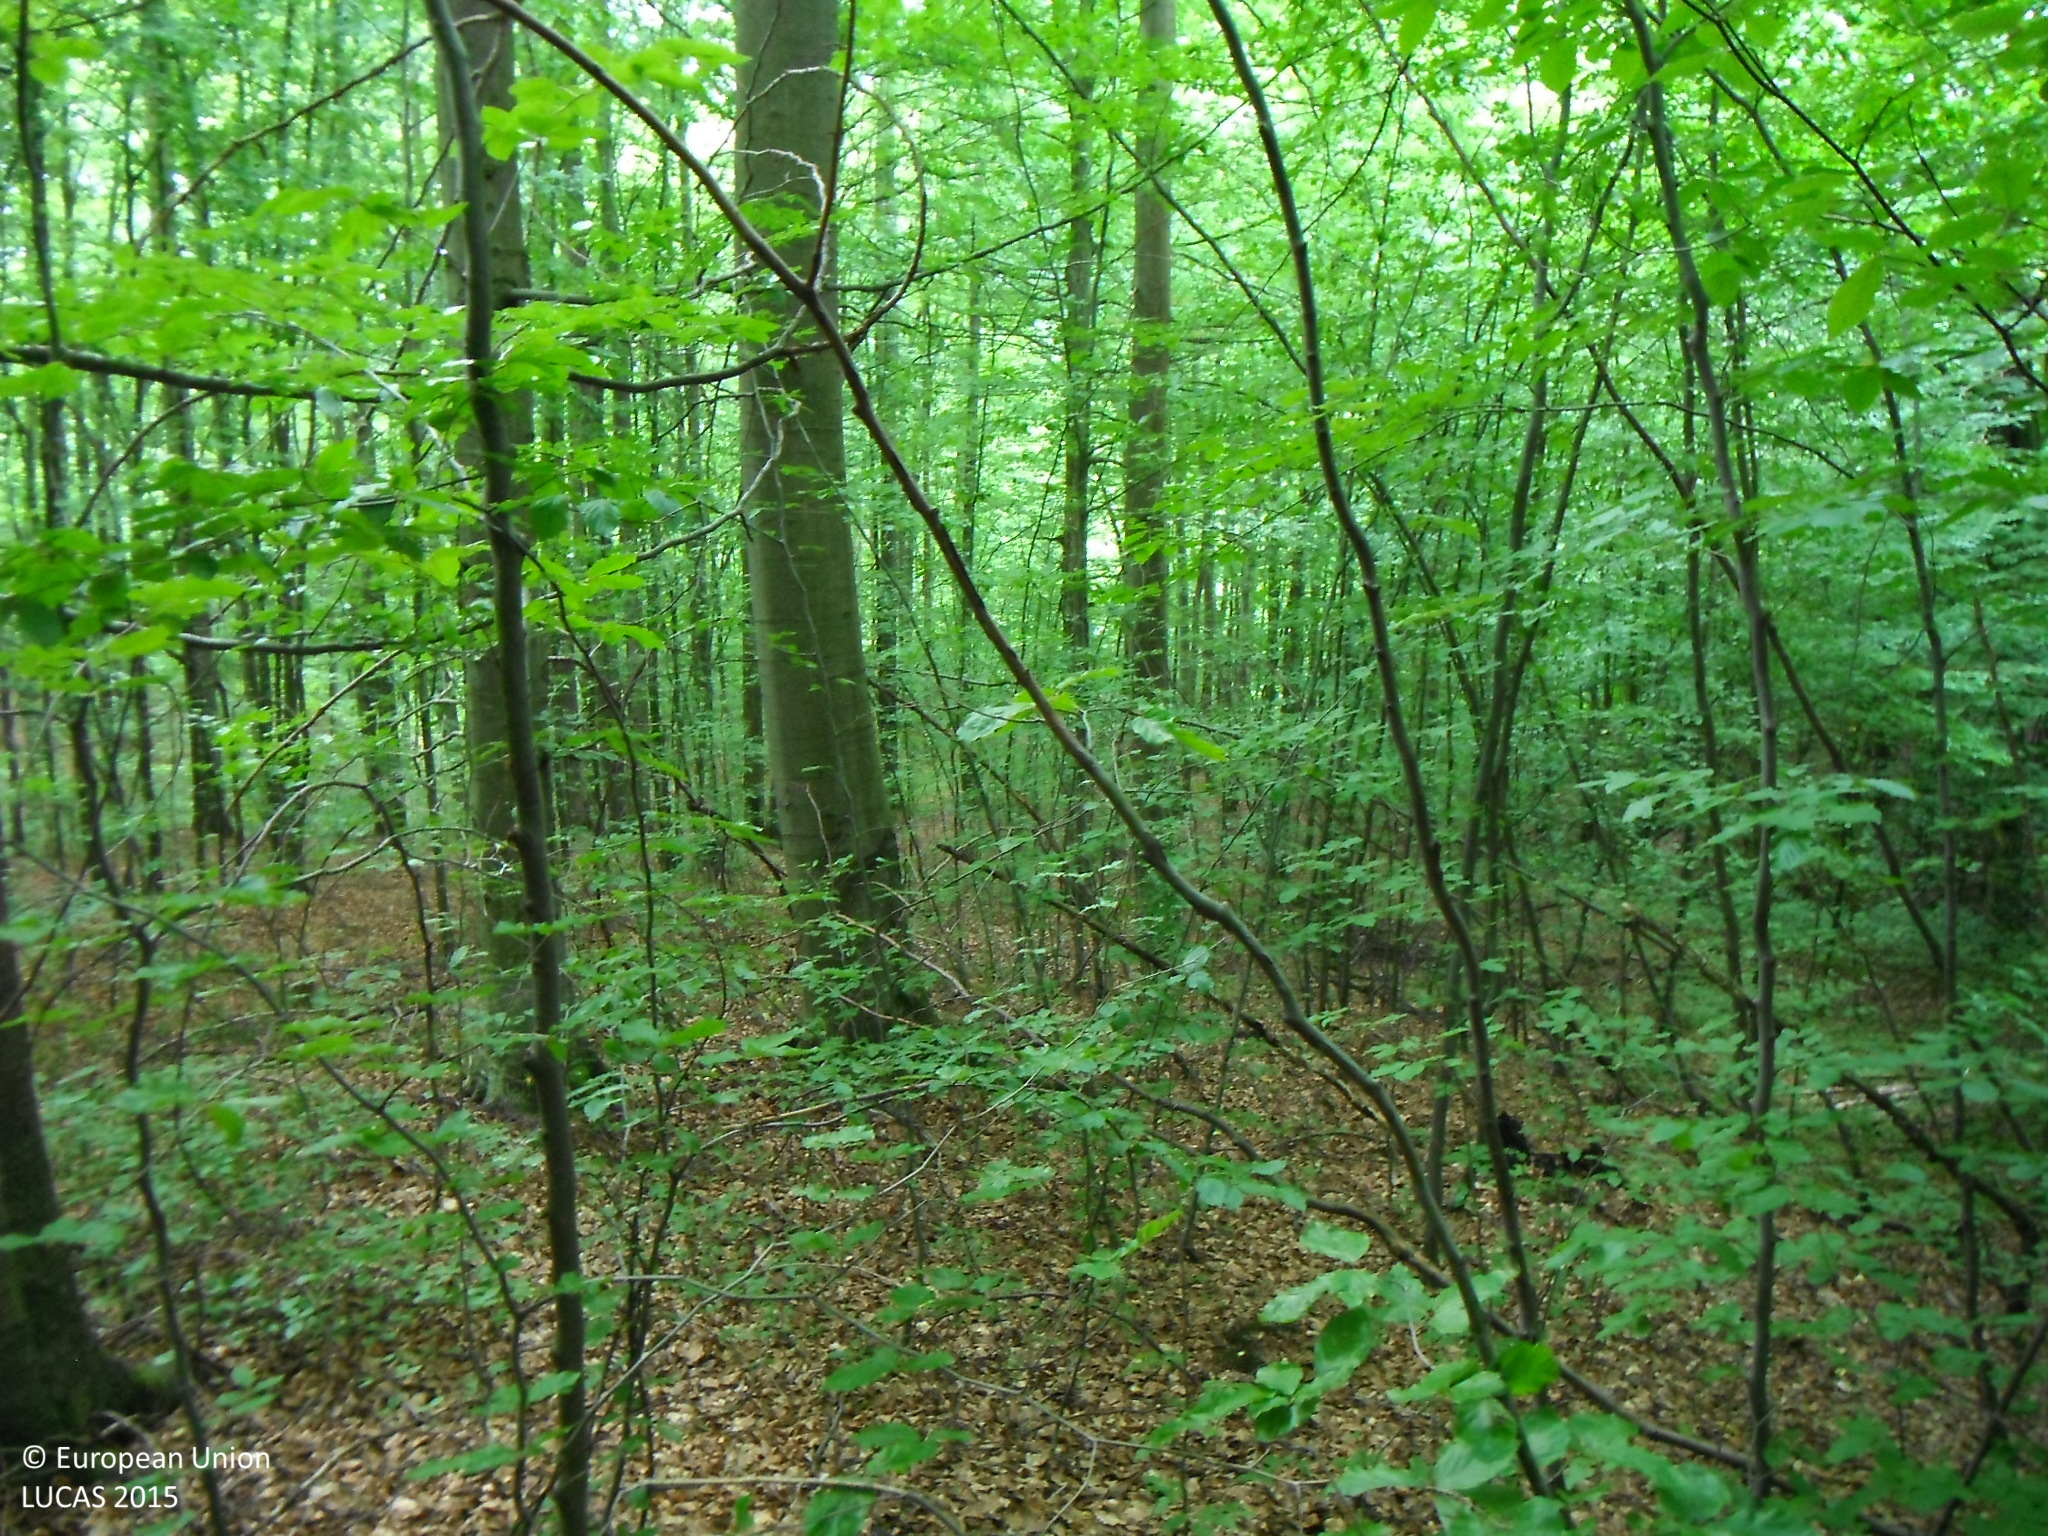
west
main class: Woodland
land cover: Broadleaved woodland
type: beech forest
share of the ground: > 75 %
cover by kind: broadleaved forest trees 100 %
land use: Forestry
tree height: > 5 m
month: July
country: SK
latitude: 49.3124
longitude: 21.6468
